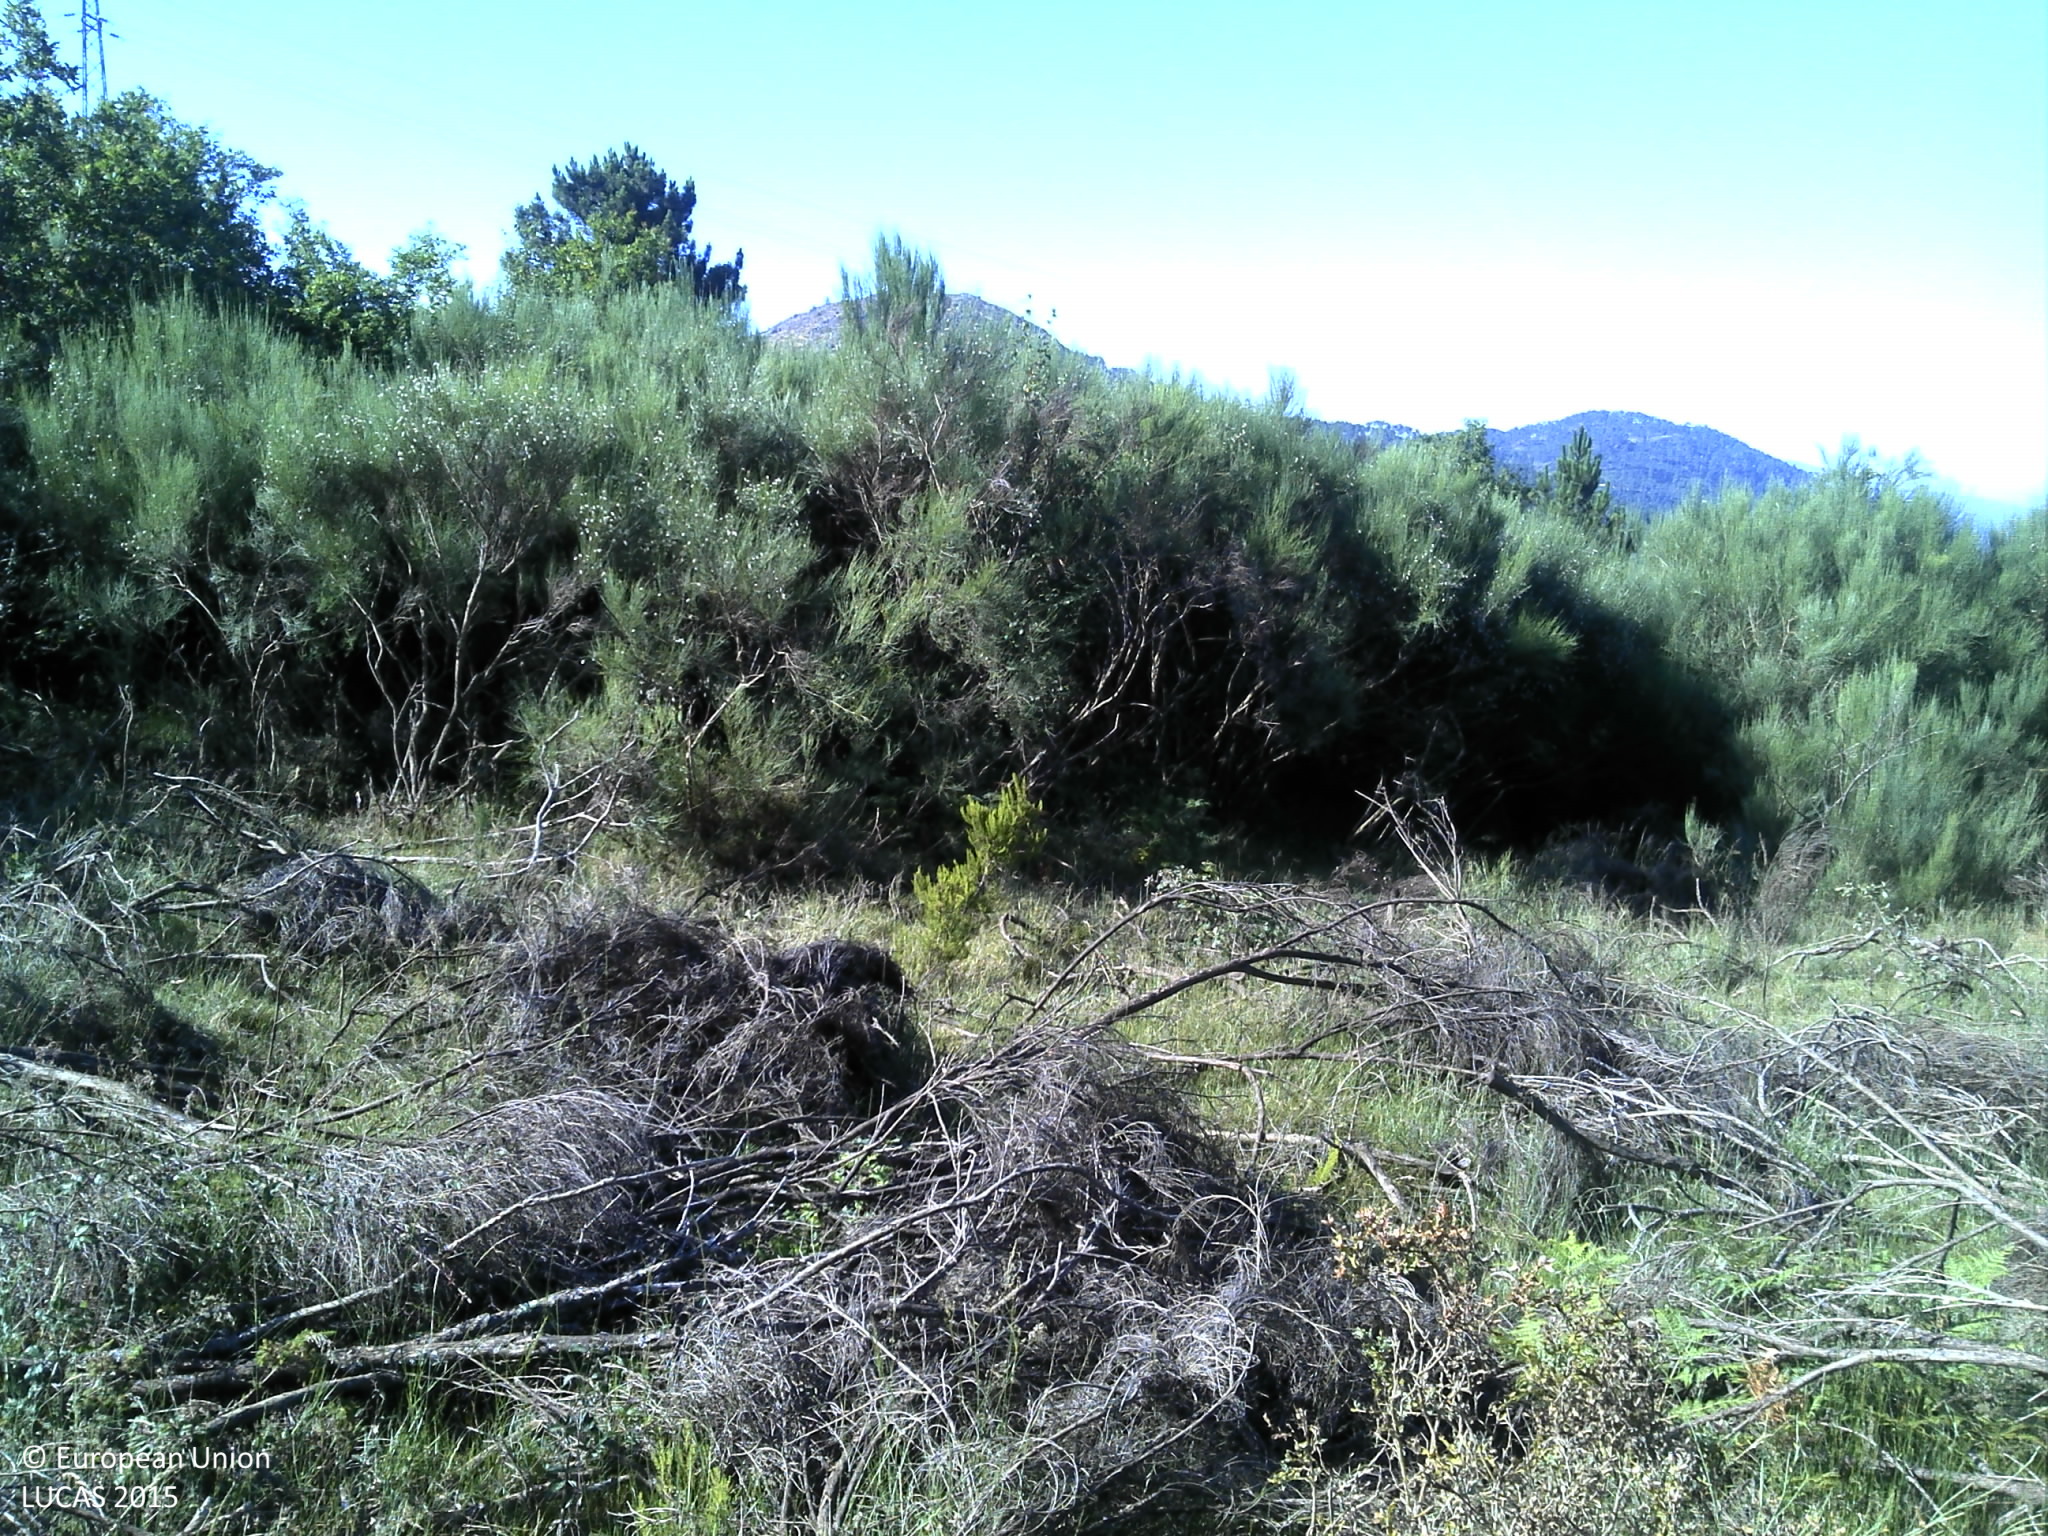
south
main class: Shrubland
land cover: Shrubland with sparse tree cover
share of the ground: > 75 %
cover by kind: shrubs 80 %, herbaceous plants 10 %, broadleaved forest trees 5 %, unconsolidated bare surface 5 %
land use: Agriculture (excluding fallow land and kitchen gardens)
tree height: < 5 m
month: July
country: PT
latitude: 41.4254
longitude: -7.8323
